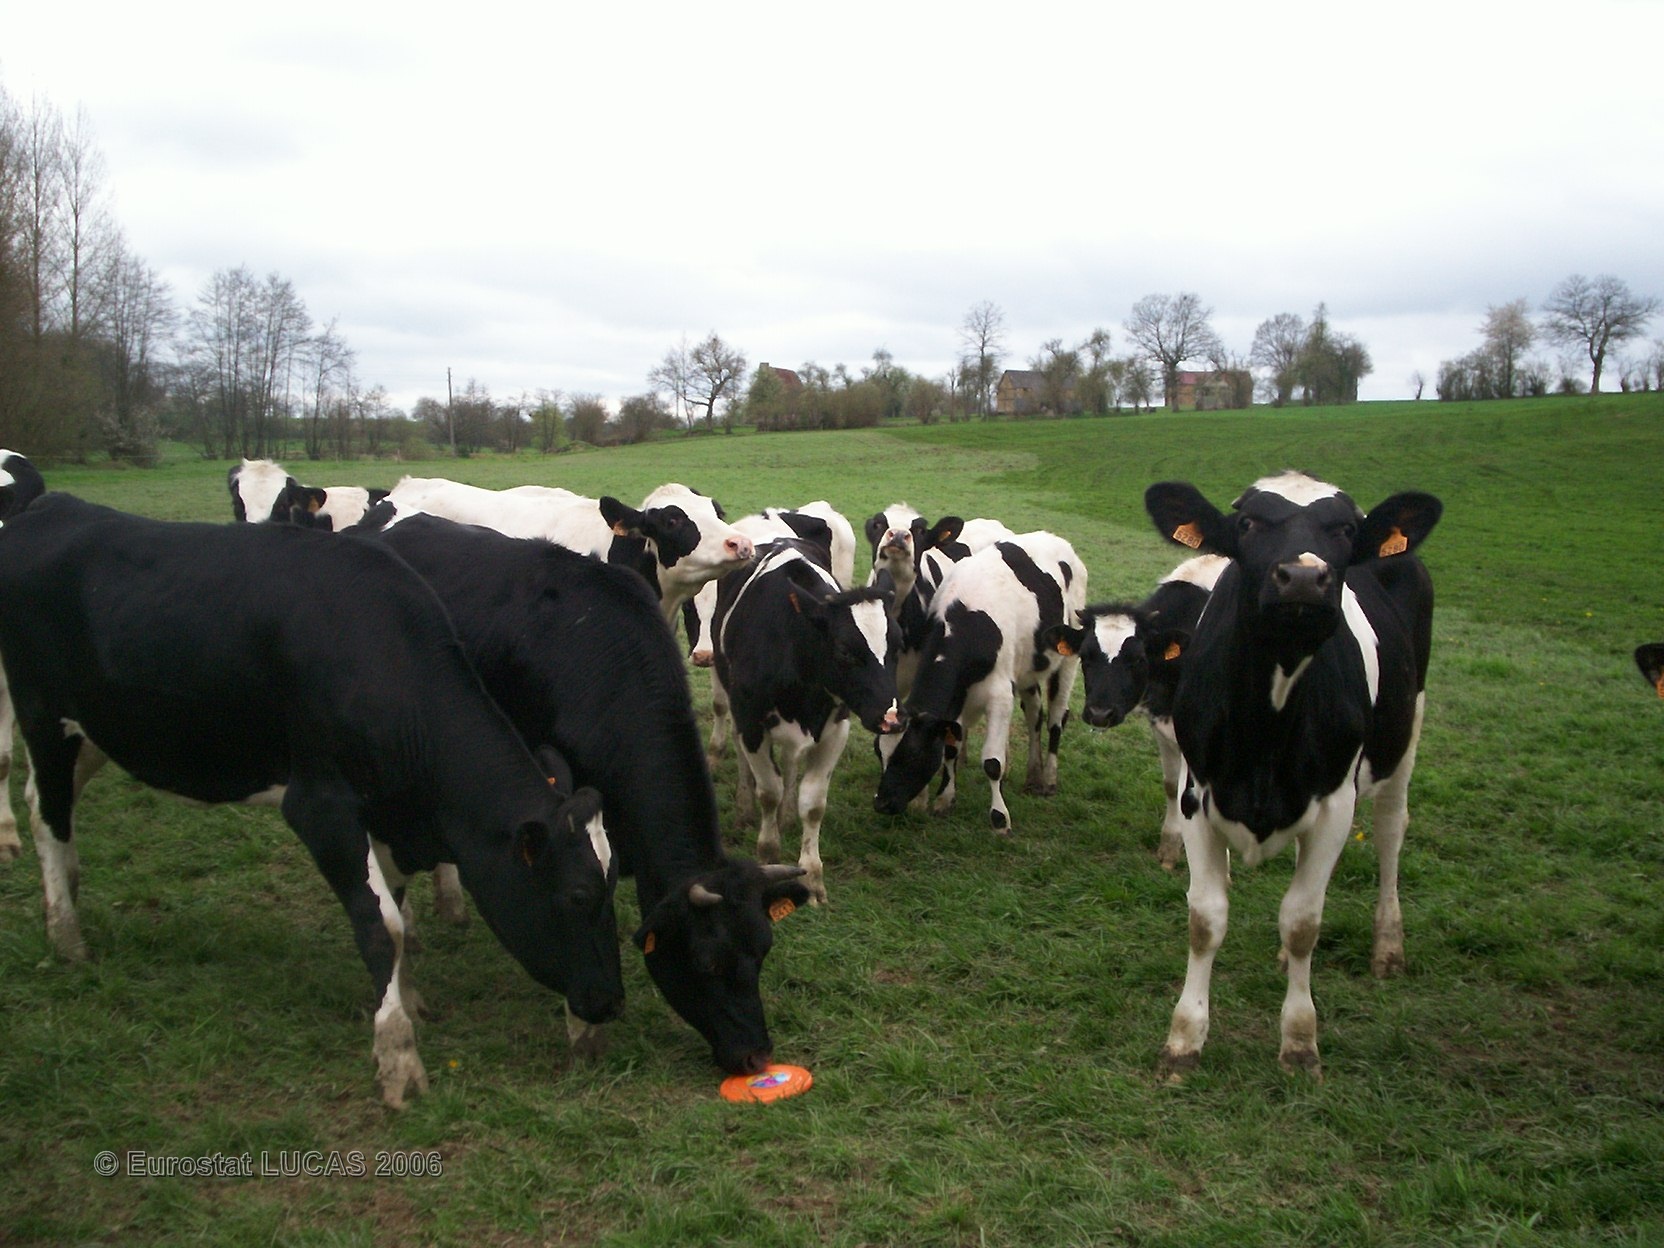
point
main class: Grassland
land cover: Grassland without tree/shrub cover
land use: Agriculture (excluding fallow land and kitchen gardens)
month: April
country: FR
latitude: 48.7146
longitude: -0.3495
